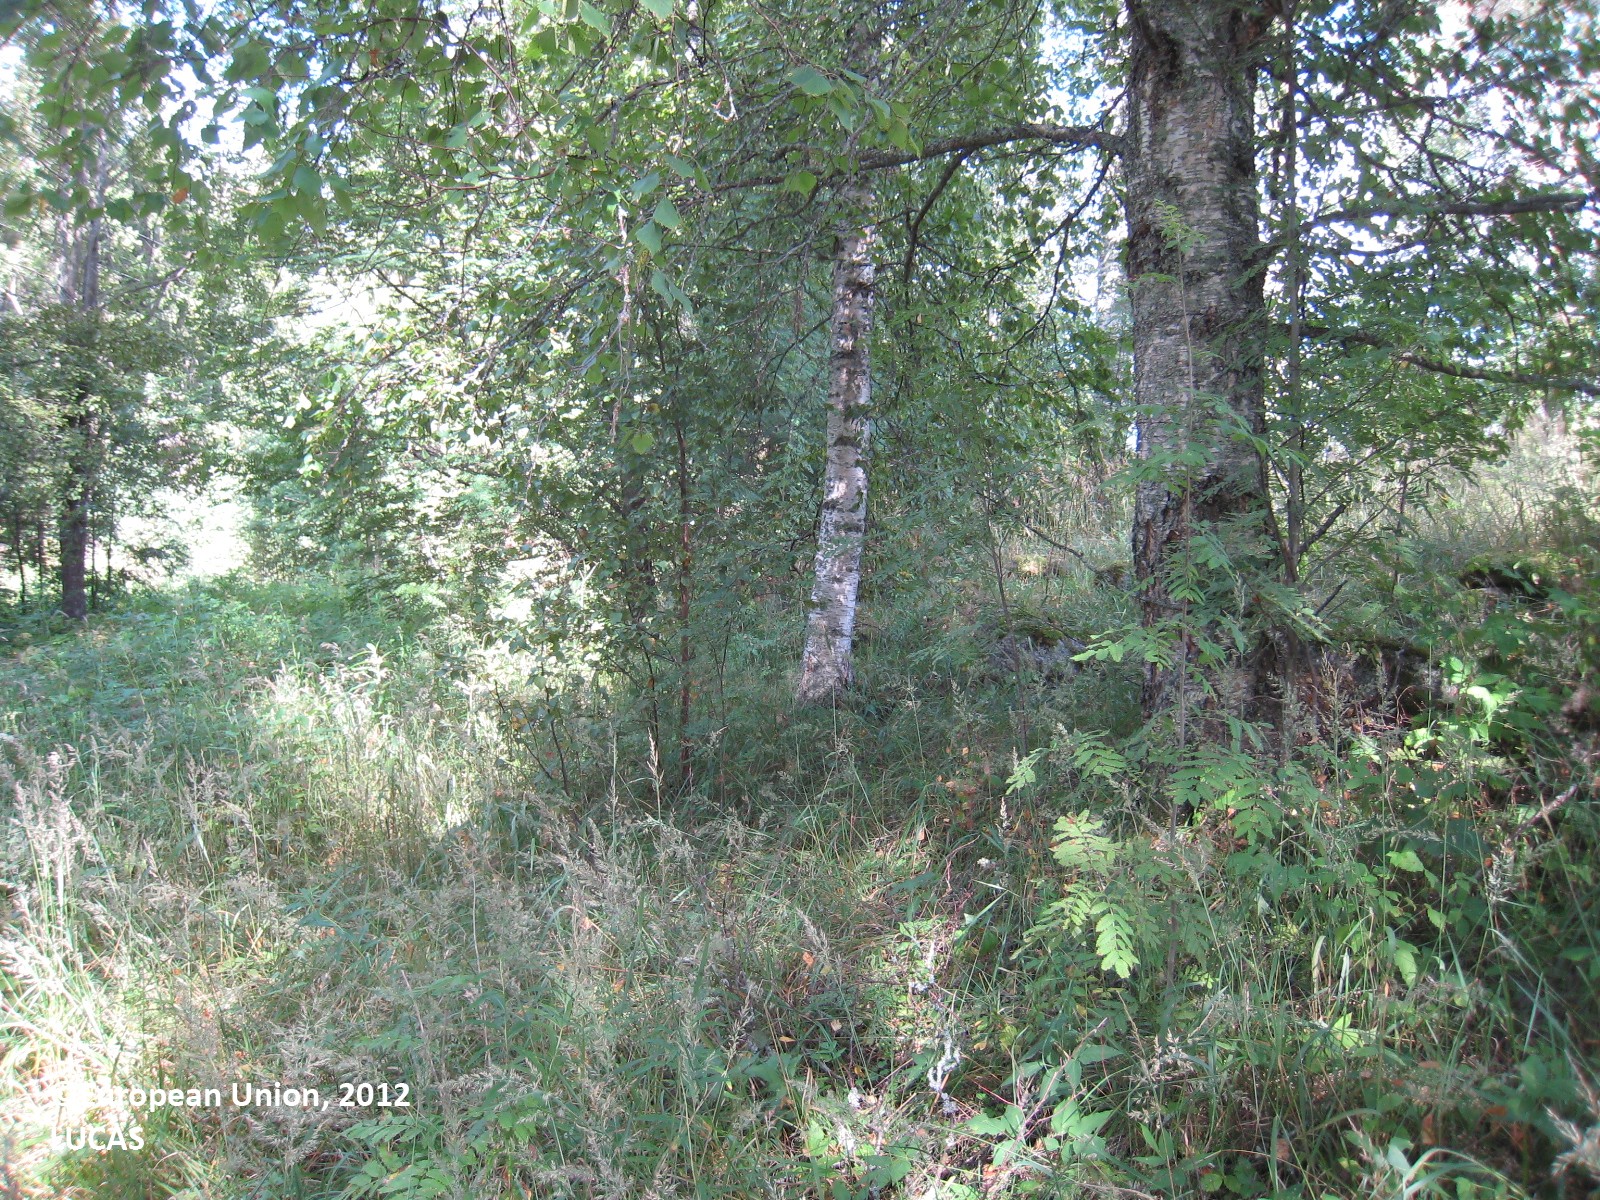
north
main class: Woodland
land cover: Other mixed woodland
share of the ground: 50 - 75 %
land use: Semi-natural and natural areas not in use
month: August
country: FI
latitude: 61.9460
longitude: 27.1838
